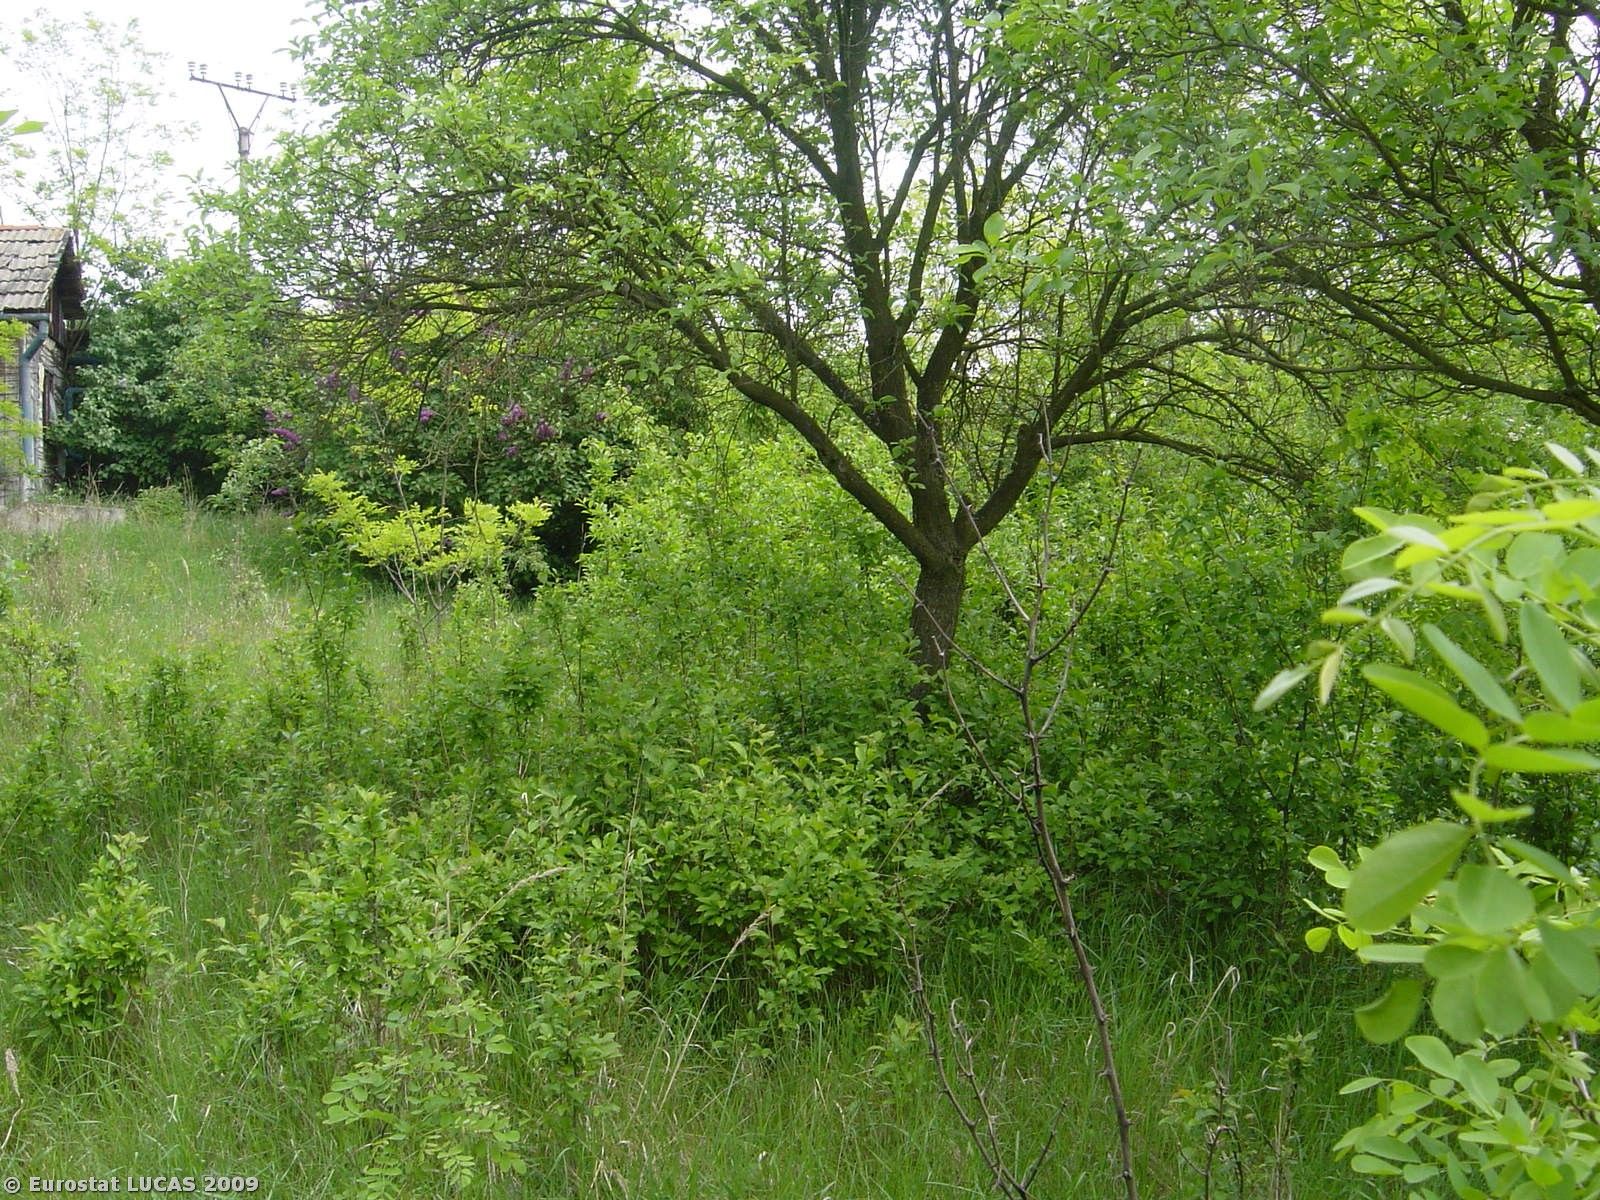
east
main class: Woodland
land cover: Broadleaved woodland
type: floodplain forest
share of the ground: > 75 %
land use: Unused
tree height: > 5 m
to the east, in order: Broadleaved woodland; Other fruit trees and berries; Grassland with sparse tree/shrub cover; Fences; Broadleaved woodland; Electric lines; Broadleaved woodland; Paved roads, cycling and walking lanes; Broadleaved woodland; Grassland without tree/shrub cover; Tracks; Vineyards; Fences; Vineyards; Fences; Barley; Grassland without tree/shrub cover; Vineyards; Grassland with sparse tree/shrub cover
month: May
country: CZ
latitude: 49.0827
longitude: 16.4279
